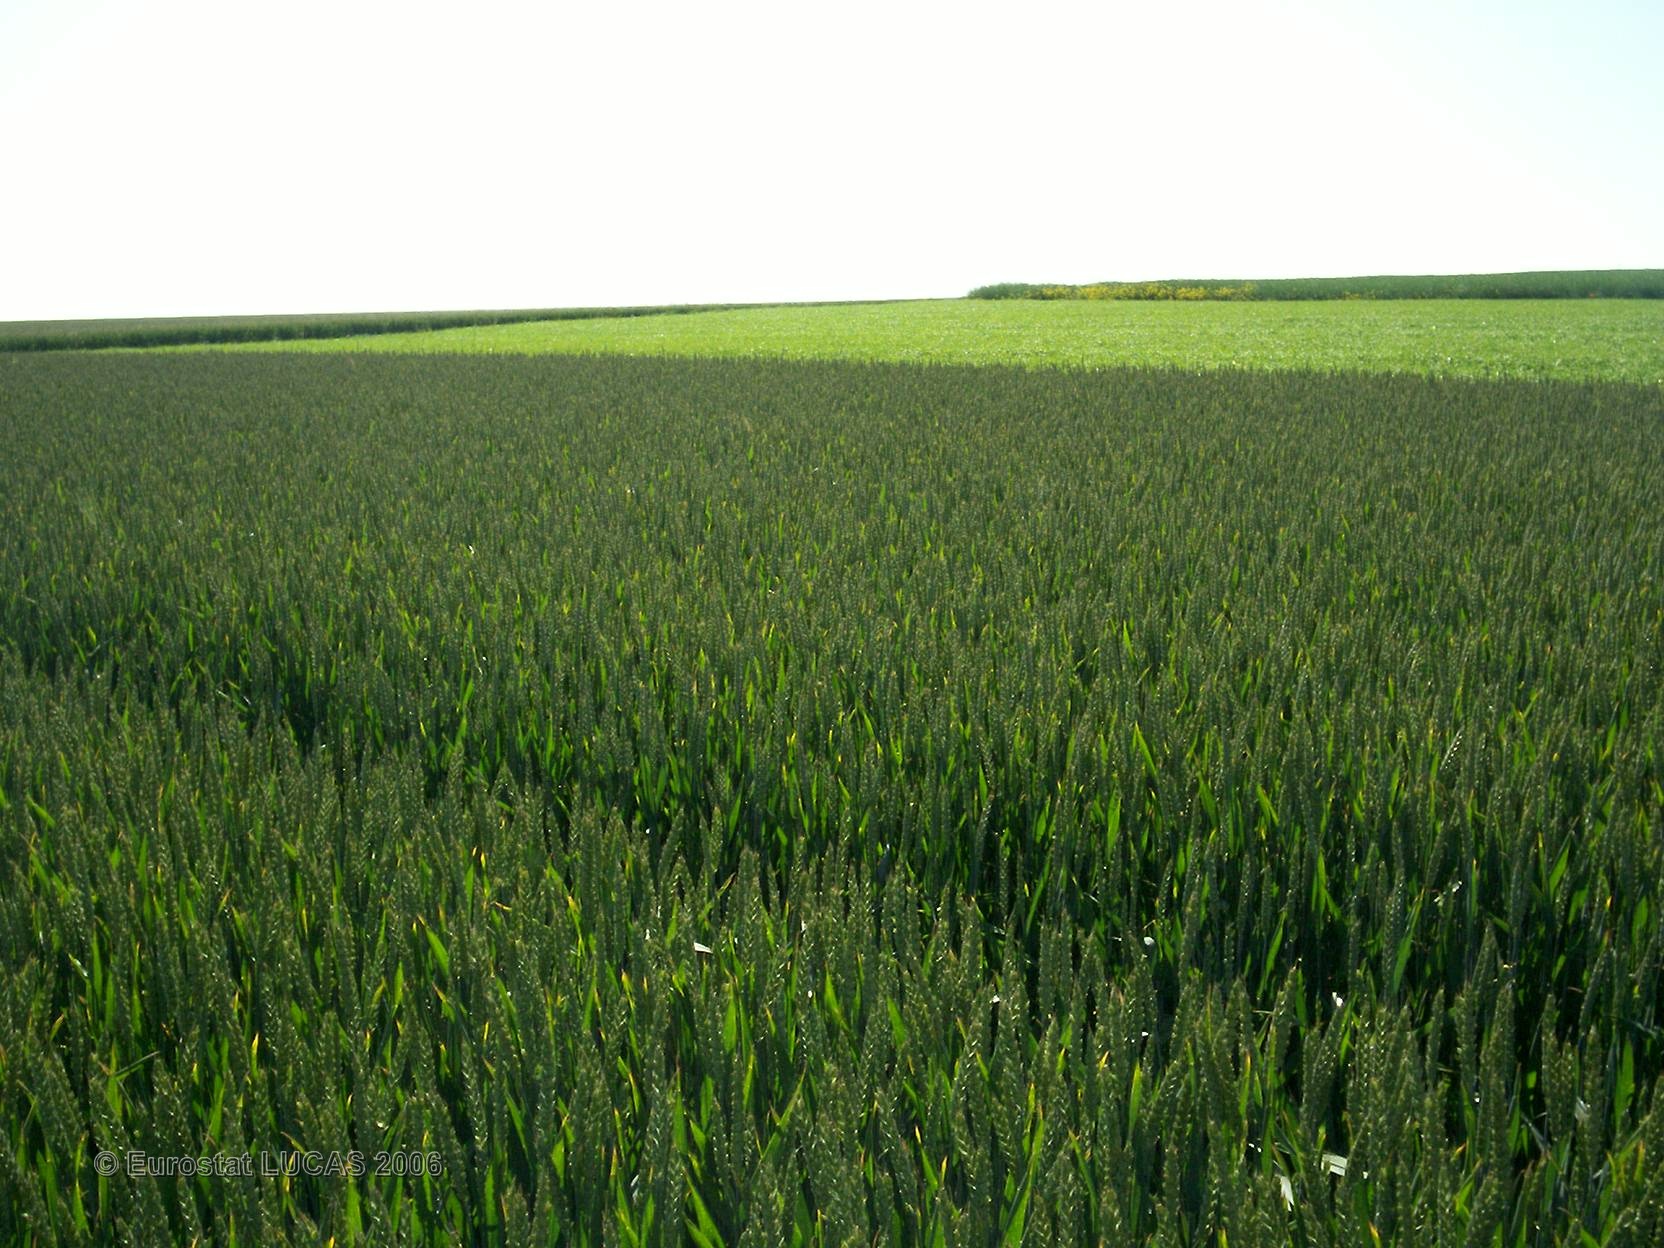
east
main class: Cropland
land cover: Common wheat
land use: Agriculture (excluding fallow land and kitchen gardens)
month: June
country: FR
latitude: 48.8233
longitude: 4.4531
